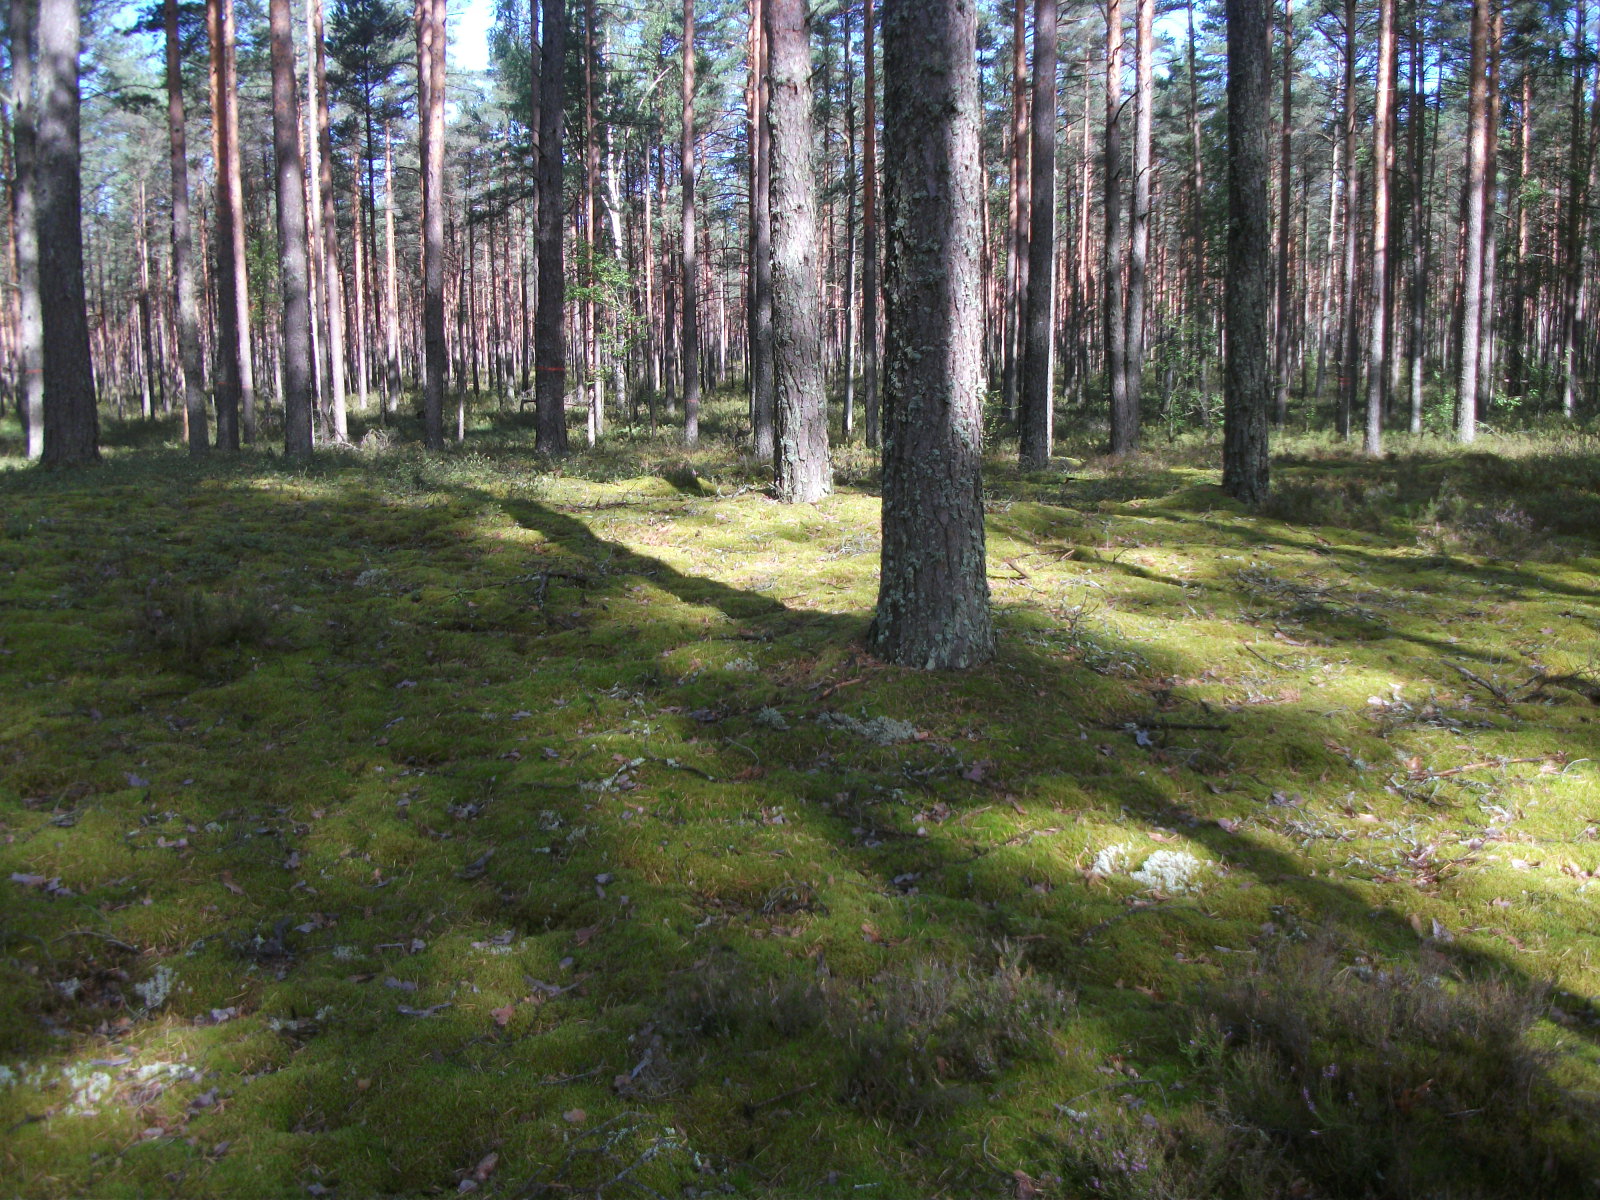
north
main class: Woodland
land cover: Pine dominated coniferous woodland
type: hemiboreal forest and nemoral coniferous forest and mixed broadleaved-coniferous forest
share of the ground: 50 - 75 %
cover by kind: coniferous forest trees 65 %, lichens and mosses 35 %
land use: Forestry
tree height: > 5 m
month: August
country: LV
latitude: 56.5058
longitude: 26.5097
